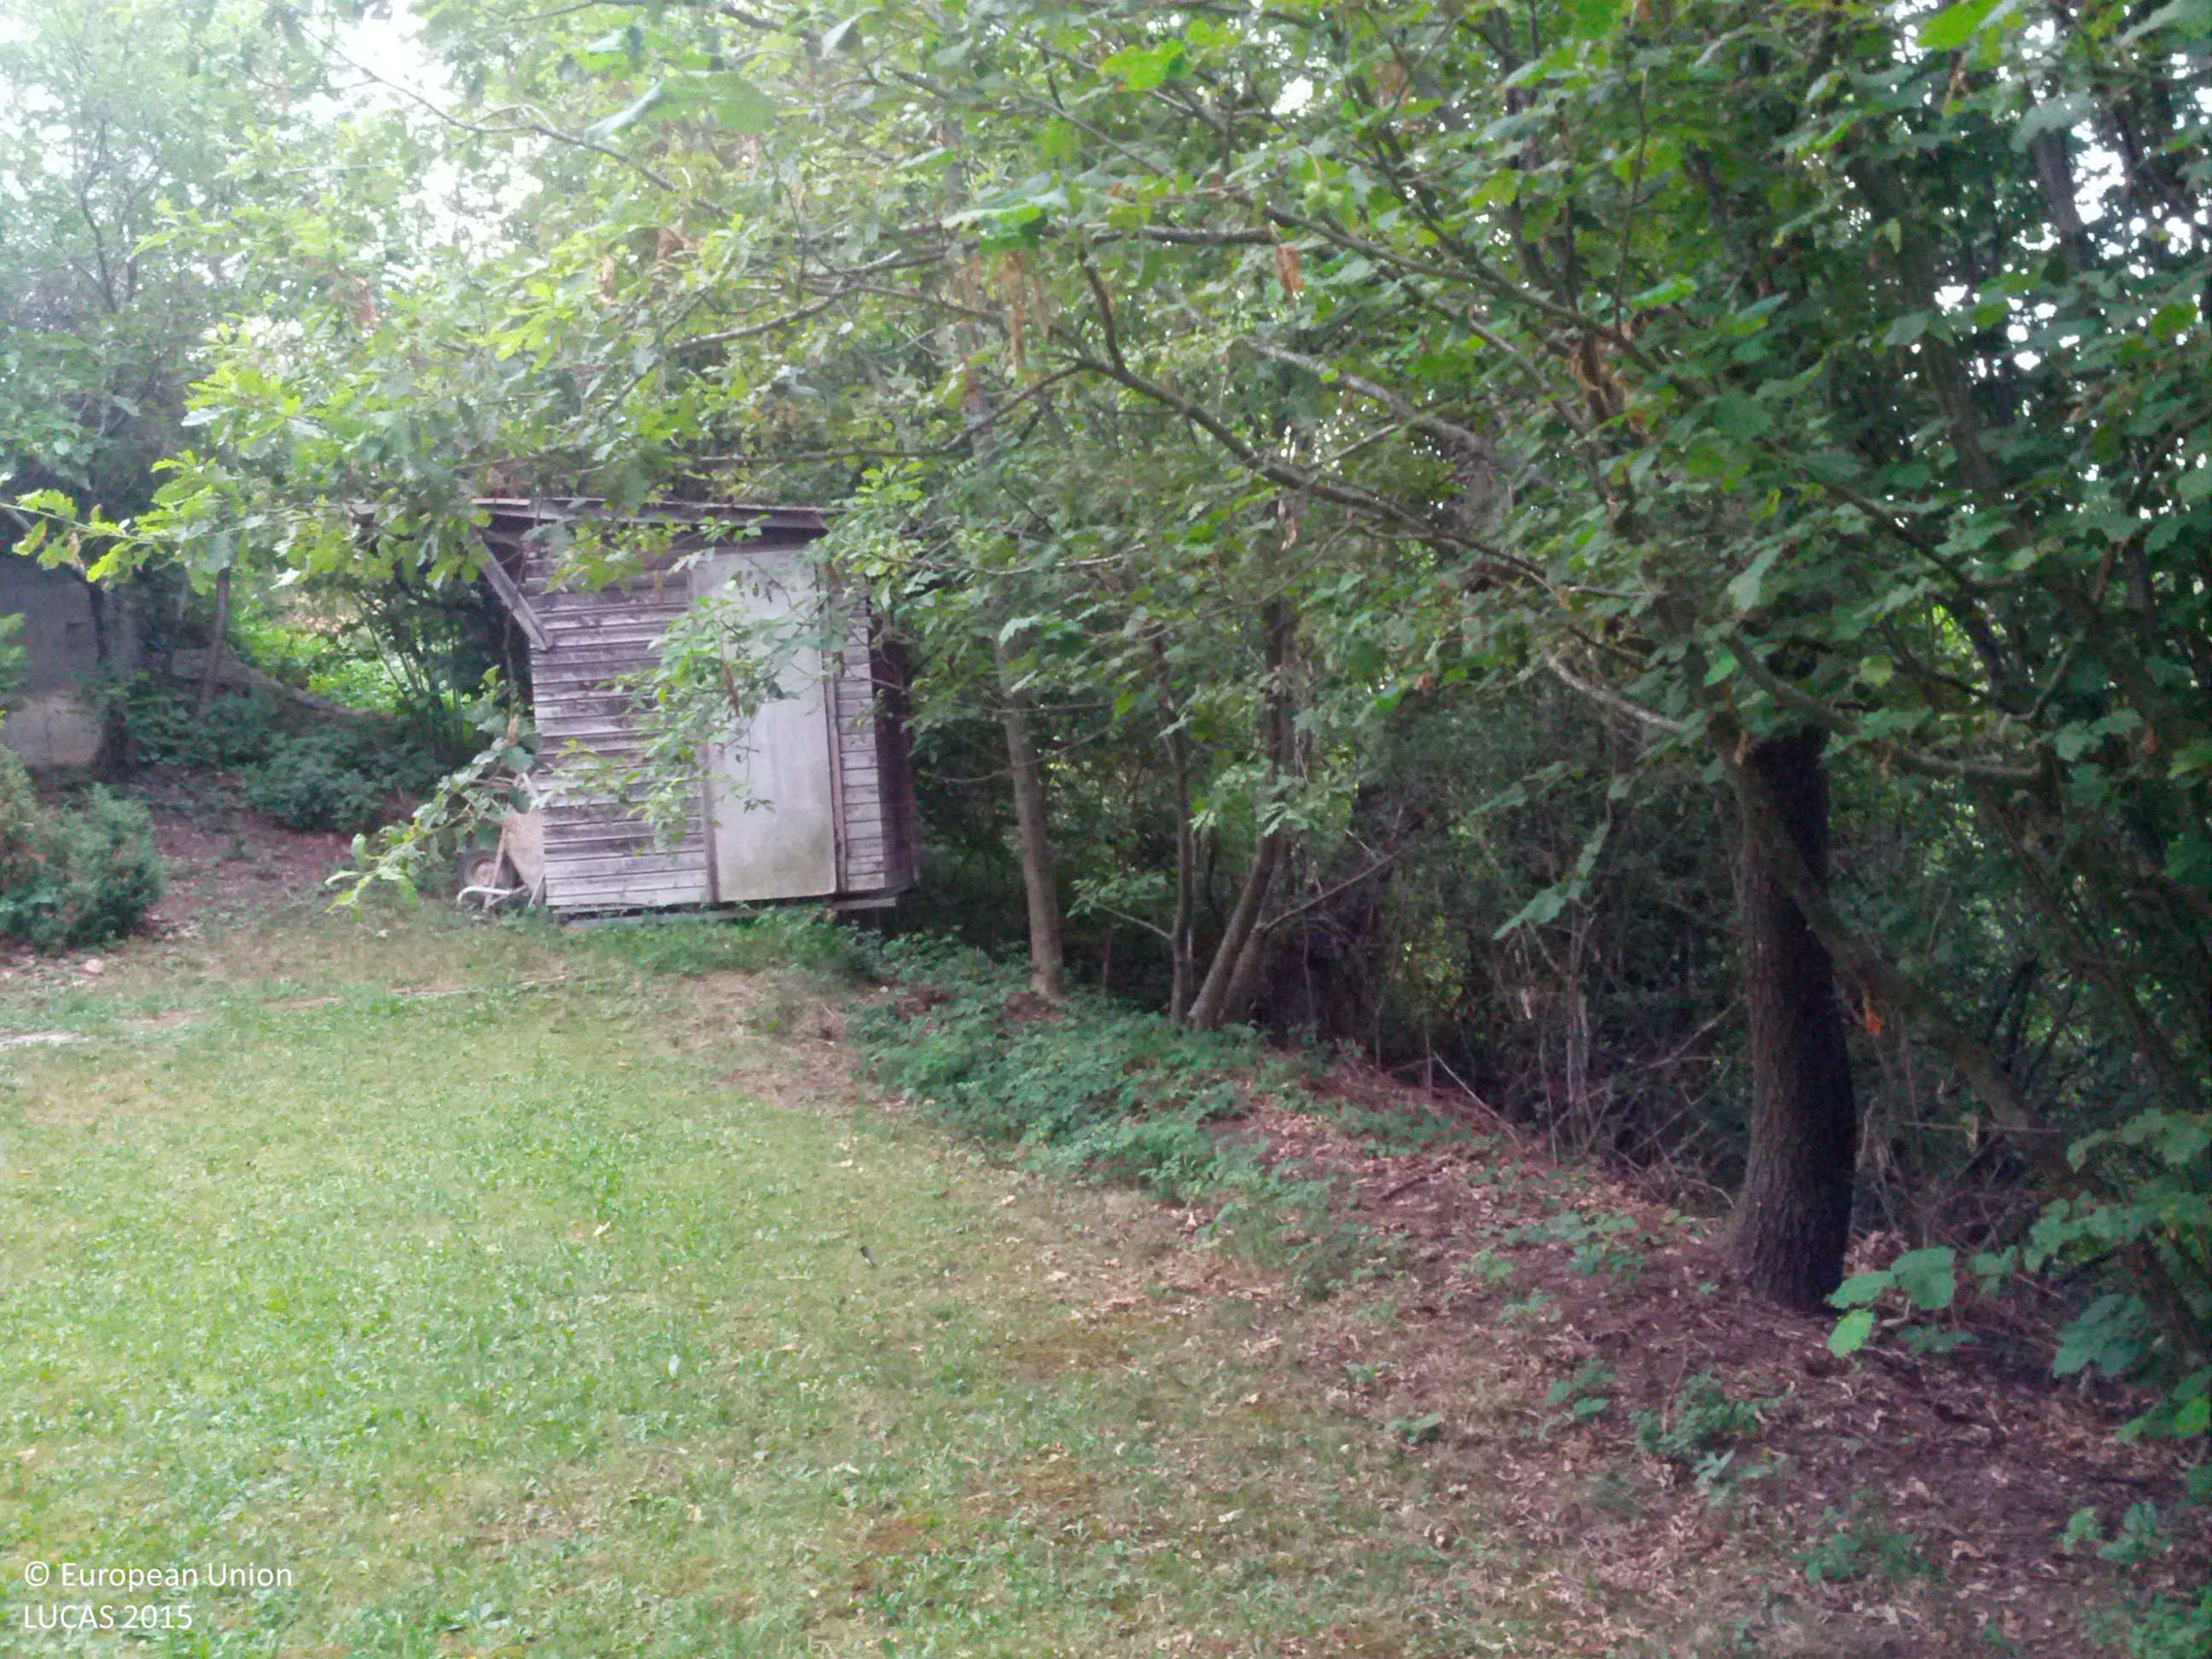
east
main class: Grassland
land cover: Grassland without tree/shrub cover
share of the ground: > 75 %
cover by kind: herbaceous plants 100 %
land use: Residential
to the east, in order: Grassland without tree/shrub cover; Broadleaved woodland; Grassland with sparse tree/shrub cover; Electric lines; Apple fruit; Grassland without tree/shrub cover; Artificial constructions in urban areas; Abandoned hedges; Dry stone walls; Grassland without tree/shrub cover
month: July
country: AT
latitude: 47.4043
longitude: 16.1111
